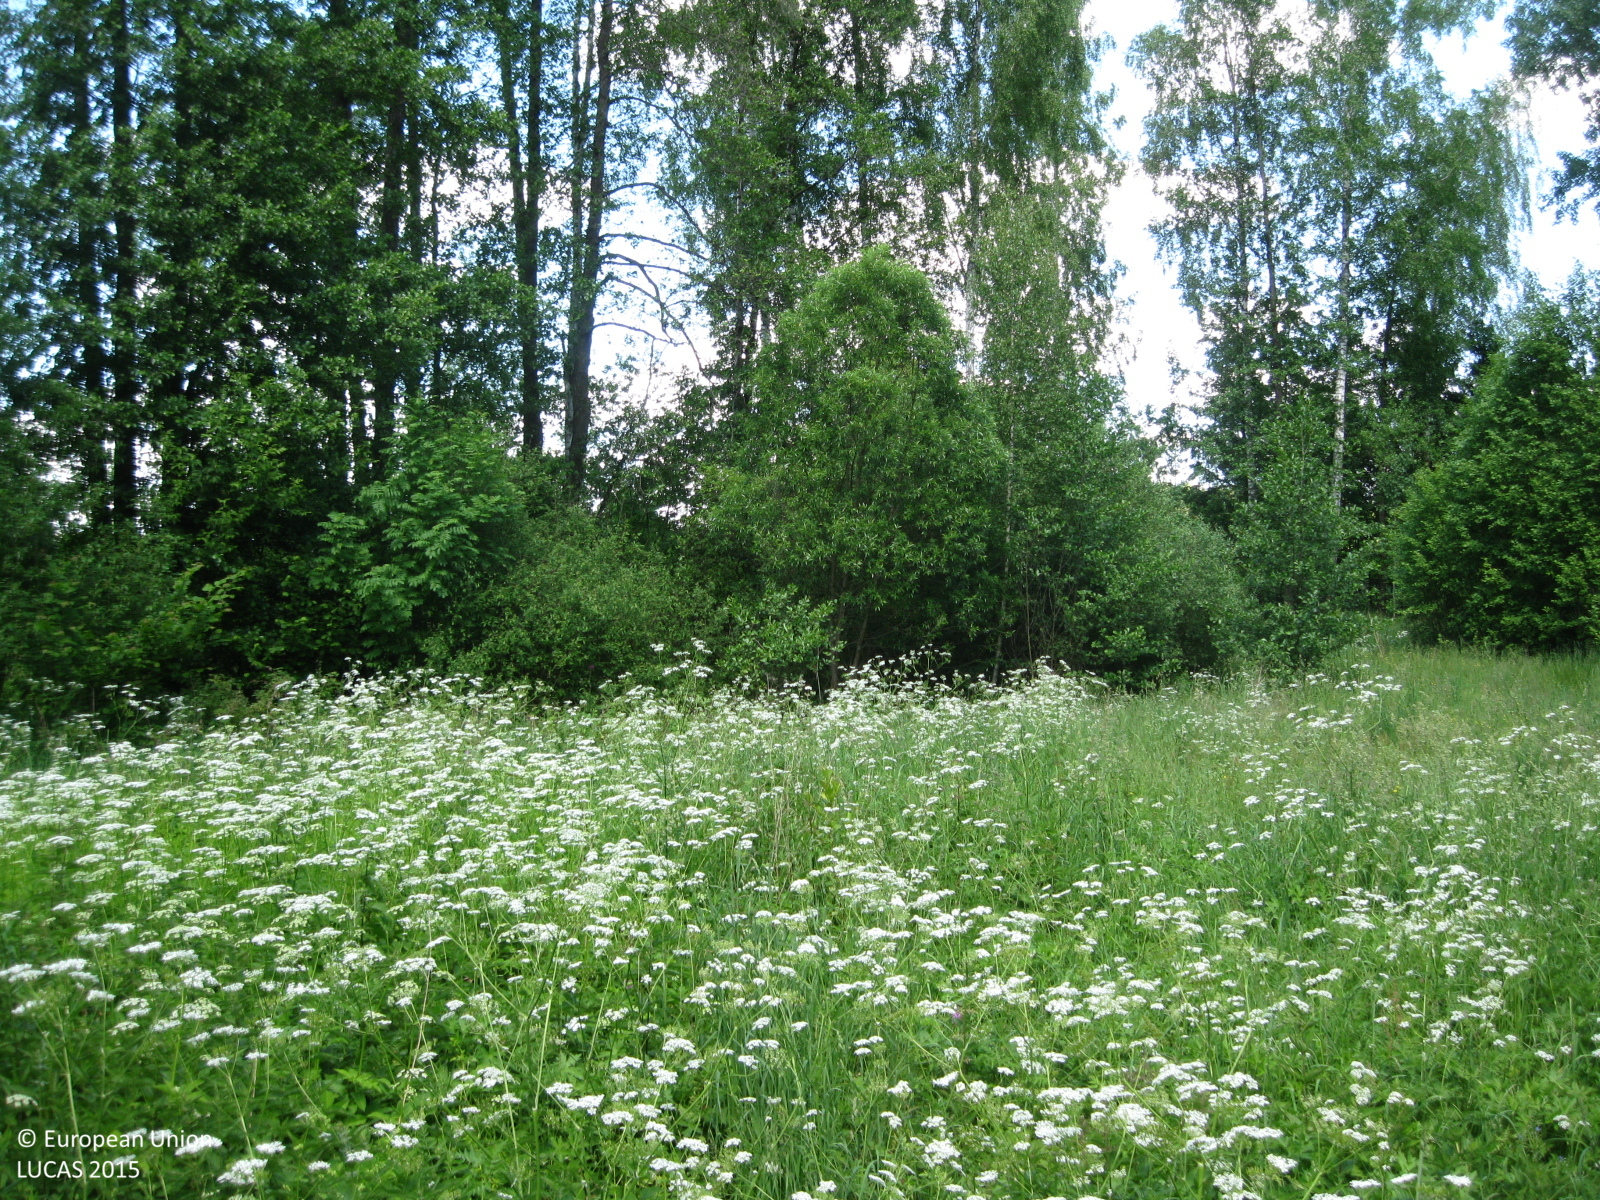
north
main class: Grassland
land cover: Spontaneously vegetated surfaces
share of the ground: > 75 %
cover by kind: herbaceous plants 100 %
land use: Semi-natural and natural areas not in use
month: June
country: LT
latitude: 55.3474
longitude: 23.9502
